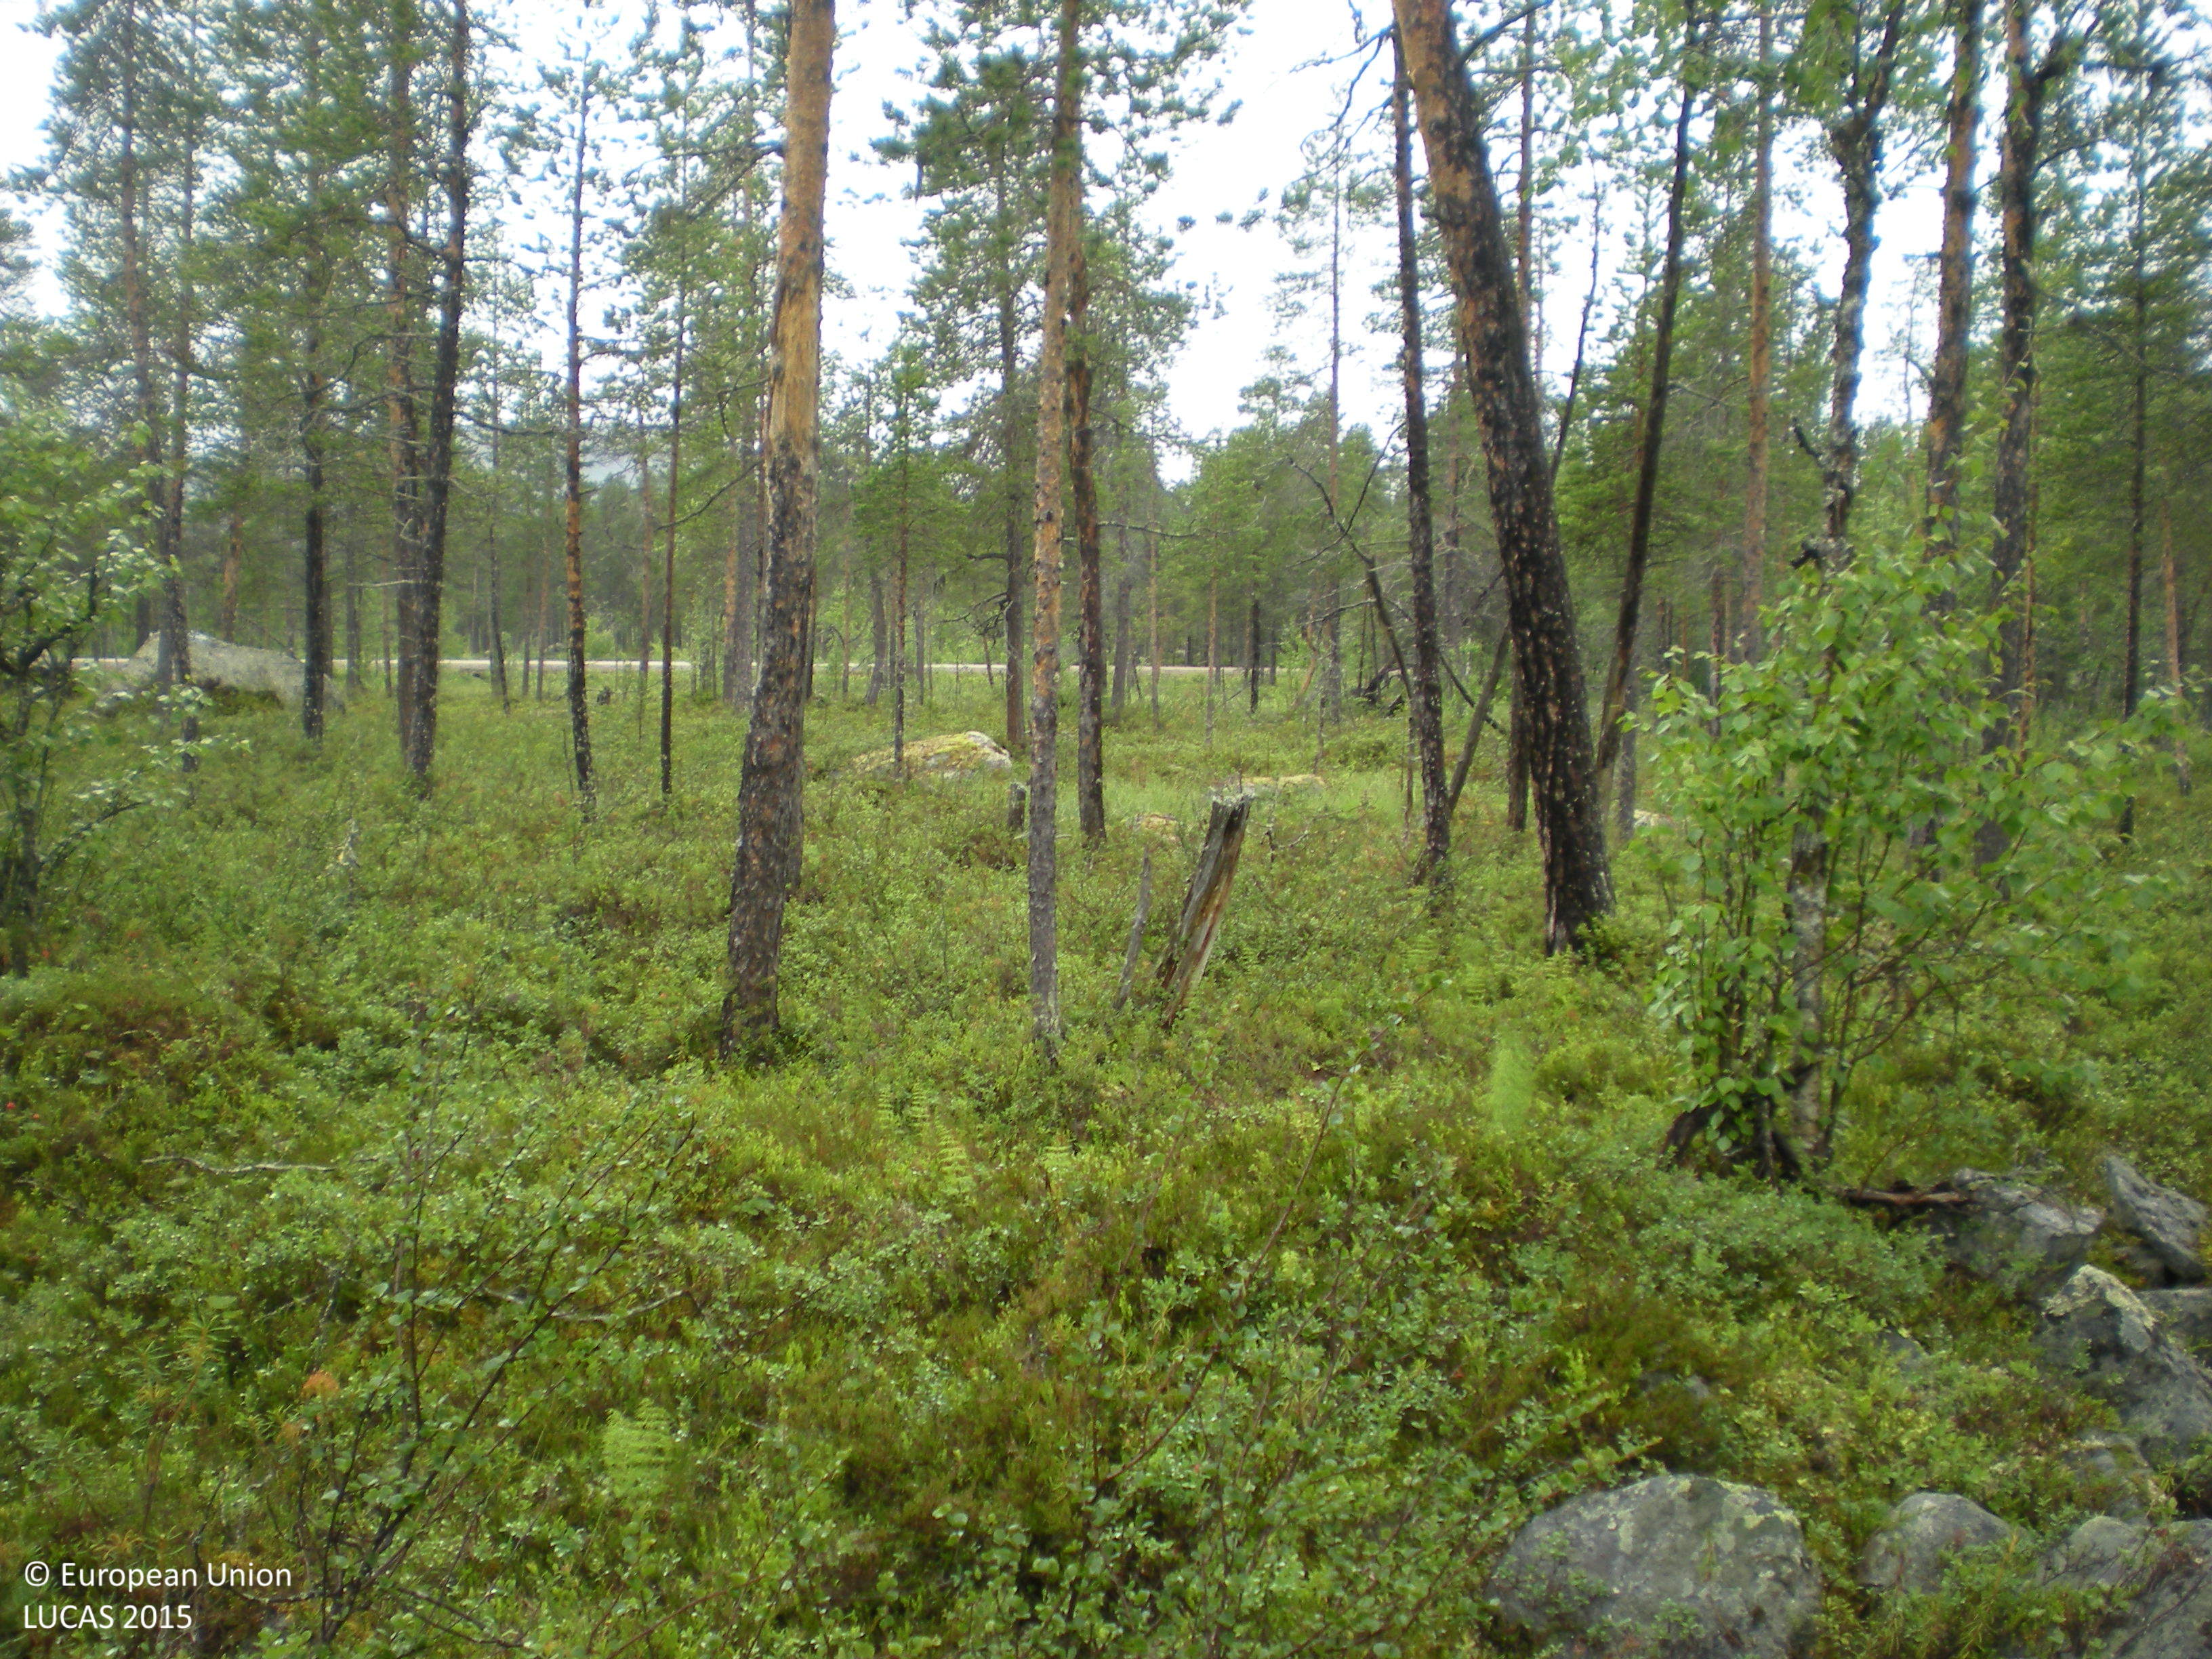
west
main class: Woodland
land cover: Pine dominated coniferous woodland
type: mire and swamp forests
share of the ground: 50 - 75 %
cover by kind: coniferous forest trees 60 %, shrubs 20 %, broadleaved forest trees 10 %, lichens and mosses 5 %, consolidated bare surface 5 %
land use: Forestry
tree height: > 5 m
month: August
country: SE
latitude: 66.1217
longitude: 18.0352
